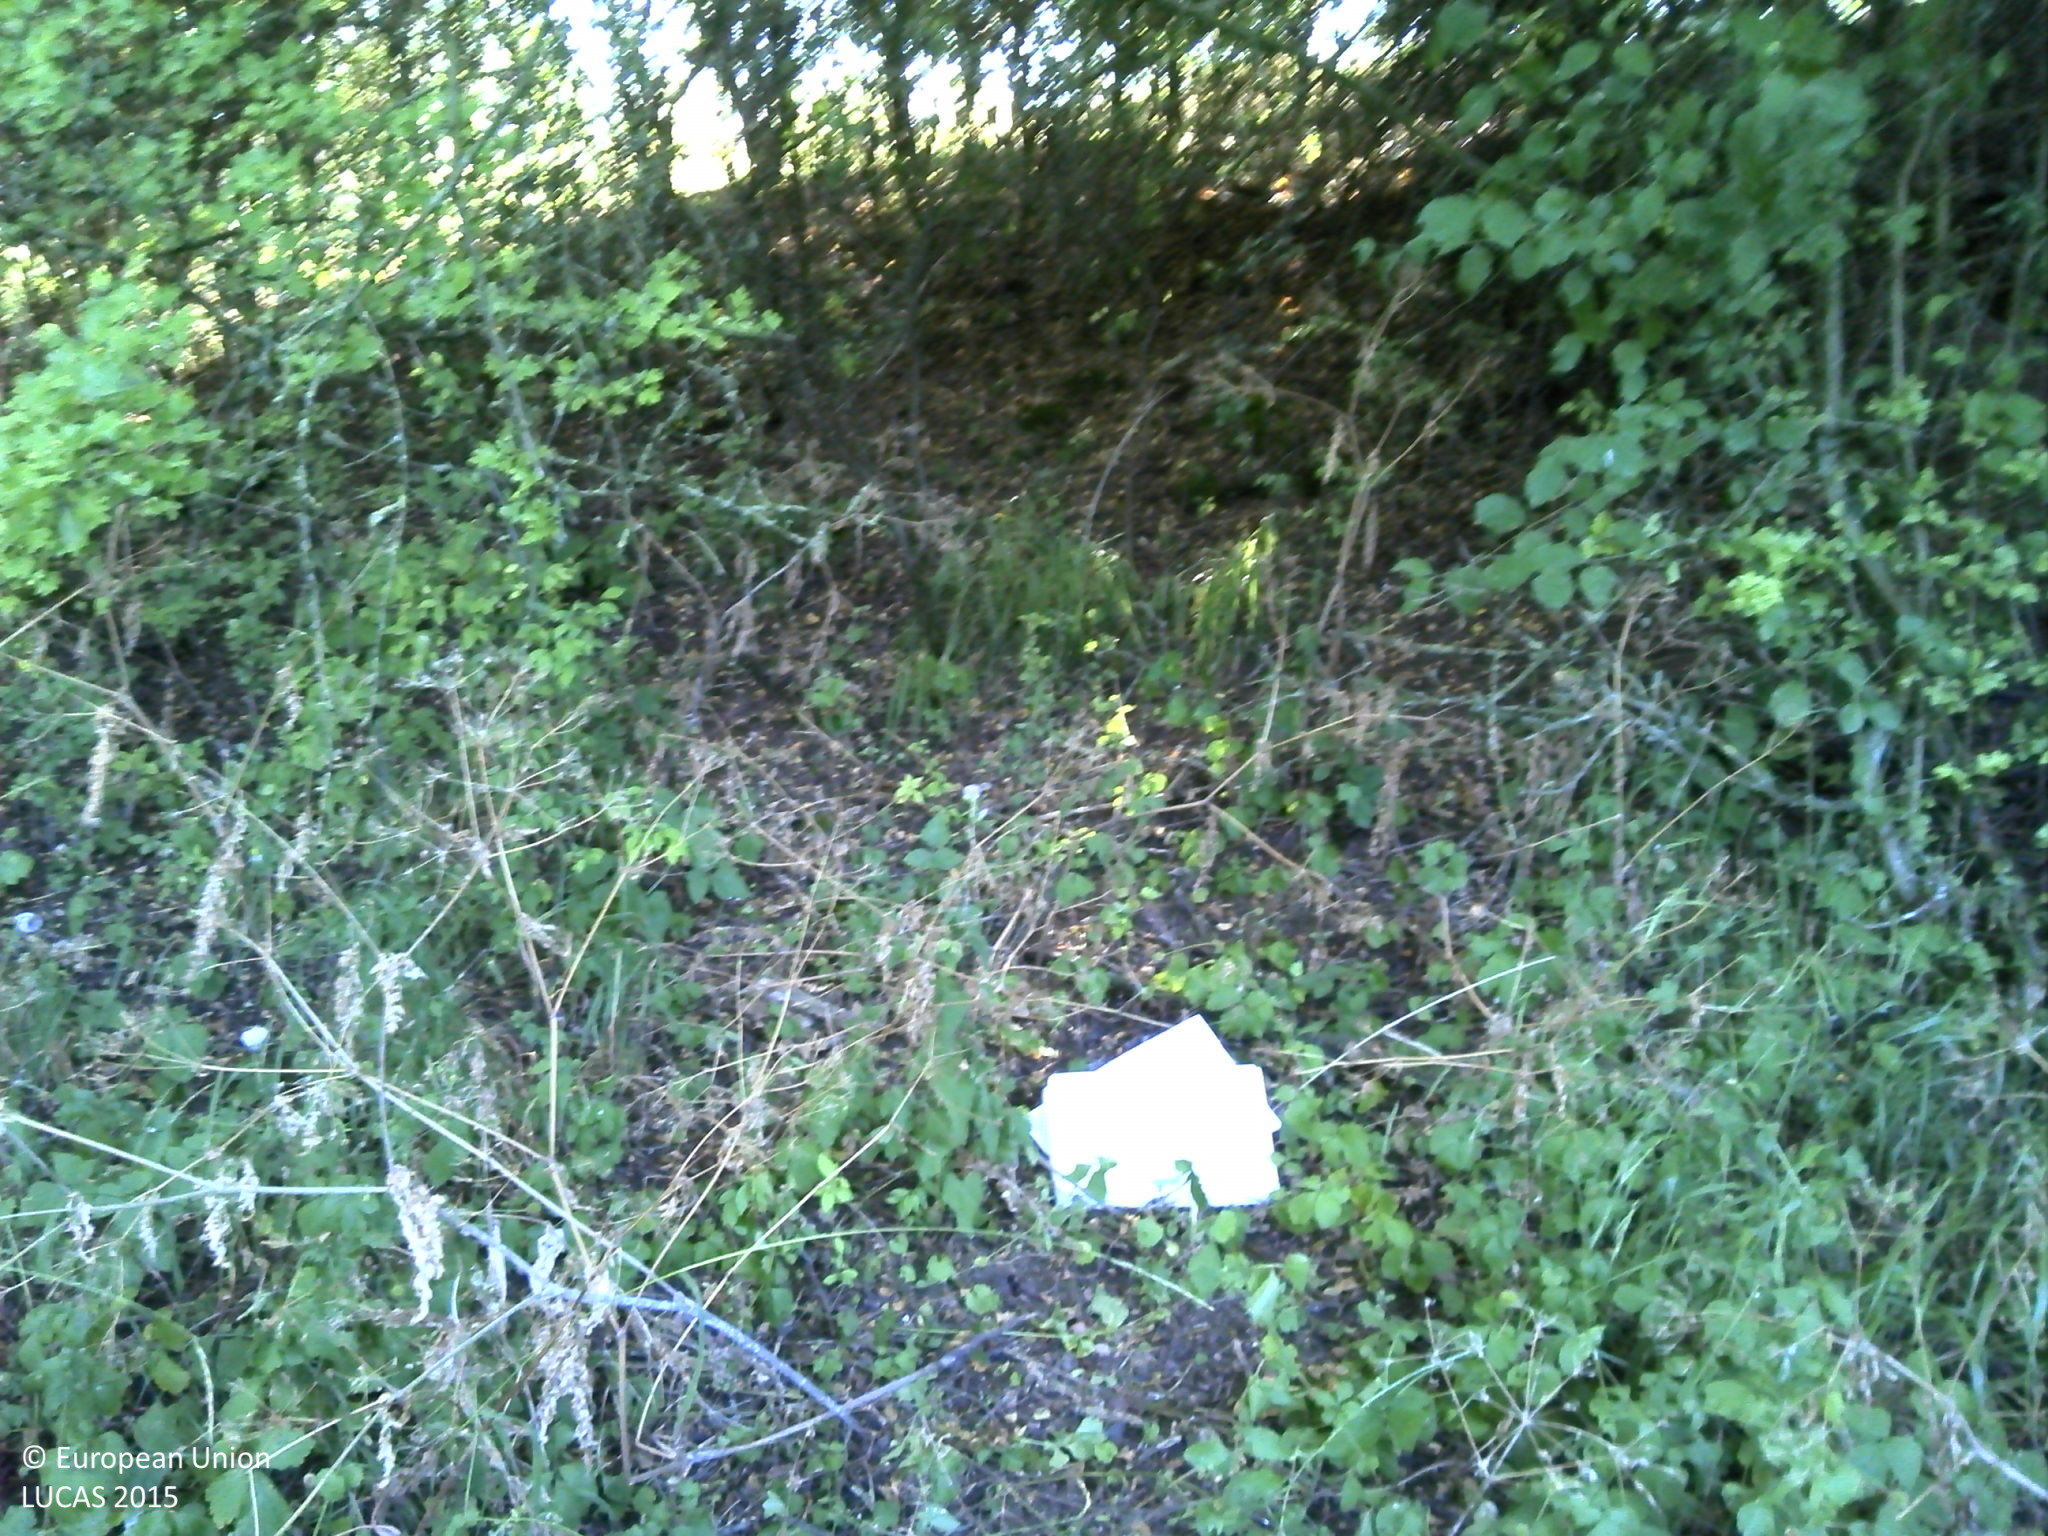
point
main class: Woodland
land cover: Broadleaved woodland
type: non-riverine alder, birch or aspen forest
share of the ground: > 75 %
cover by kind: broadleaved forest trees 100 %
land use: Semi-natural and natural areas not in use
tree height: > 5 m
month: July
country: FR
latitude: 49.2313
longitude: 6.5256
